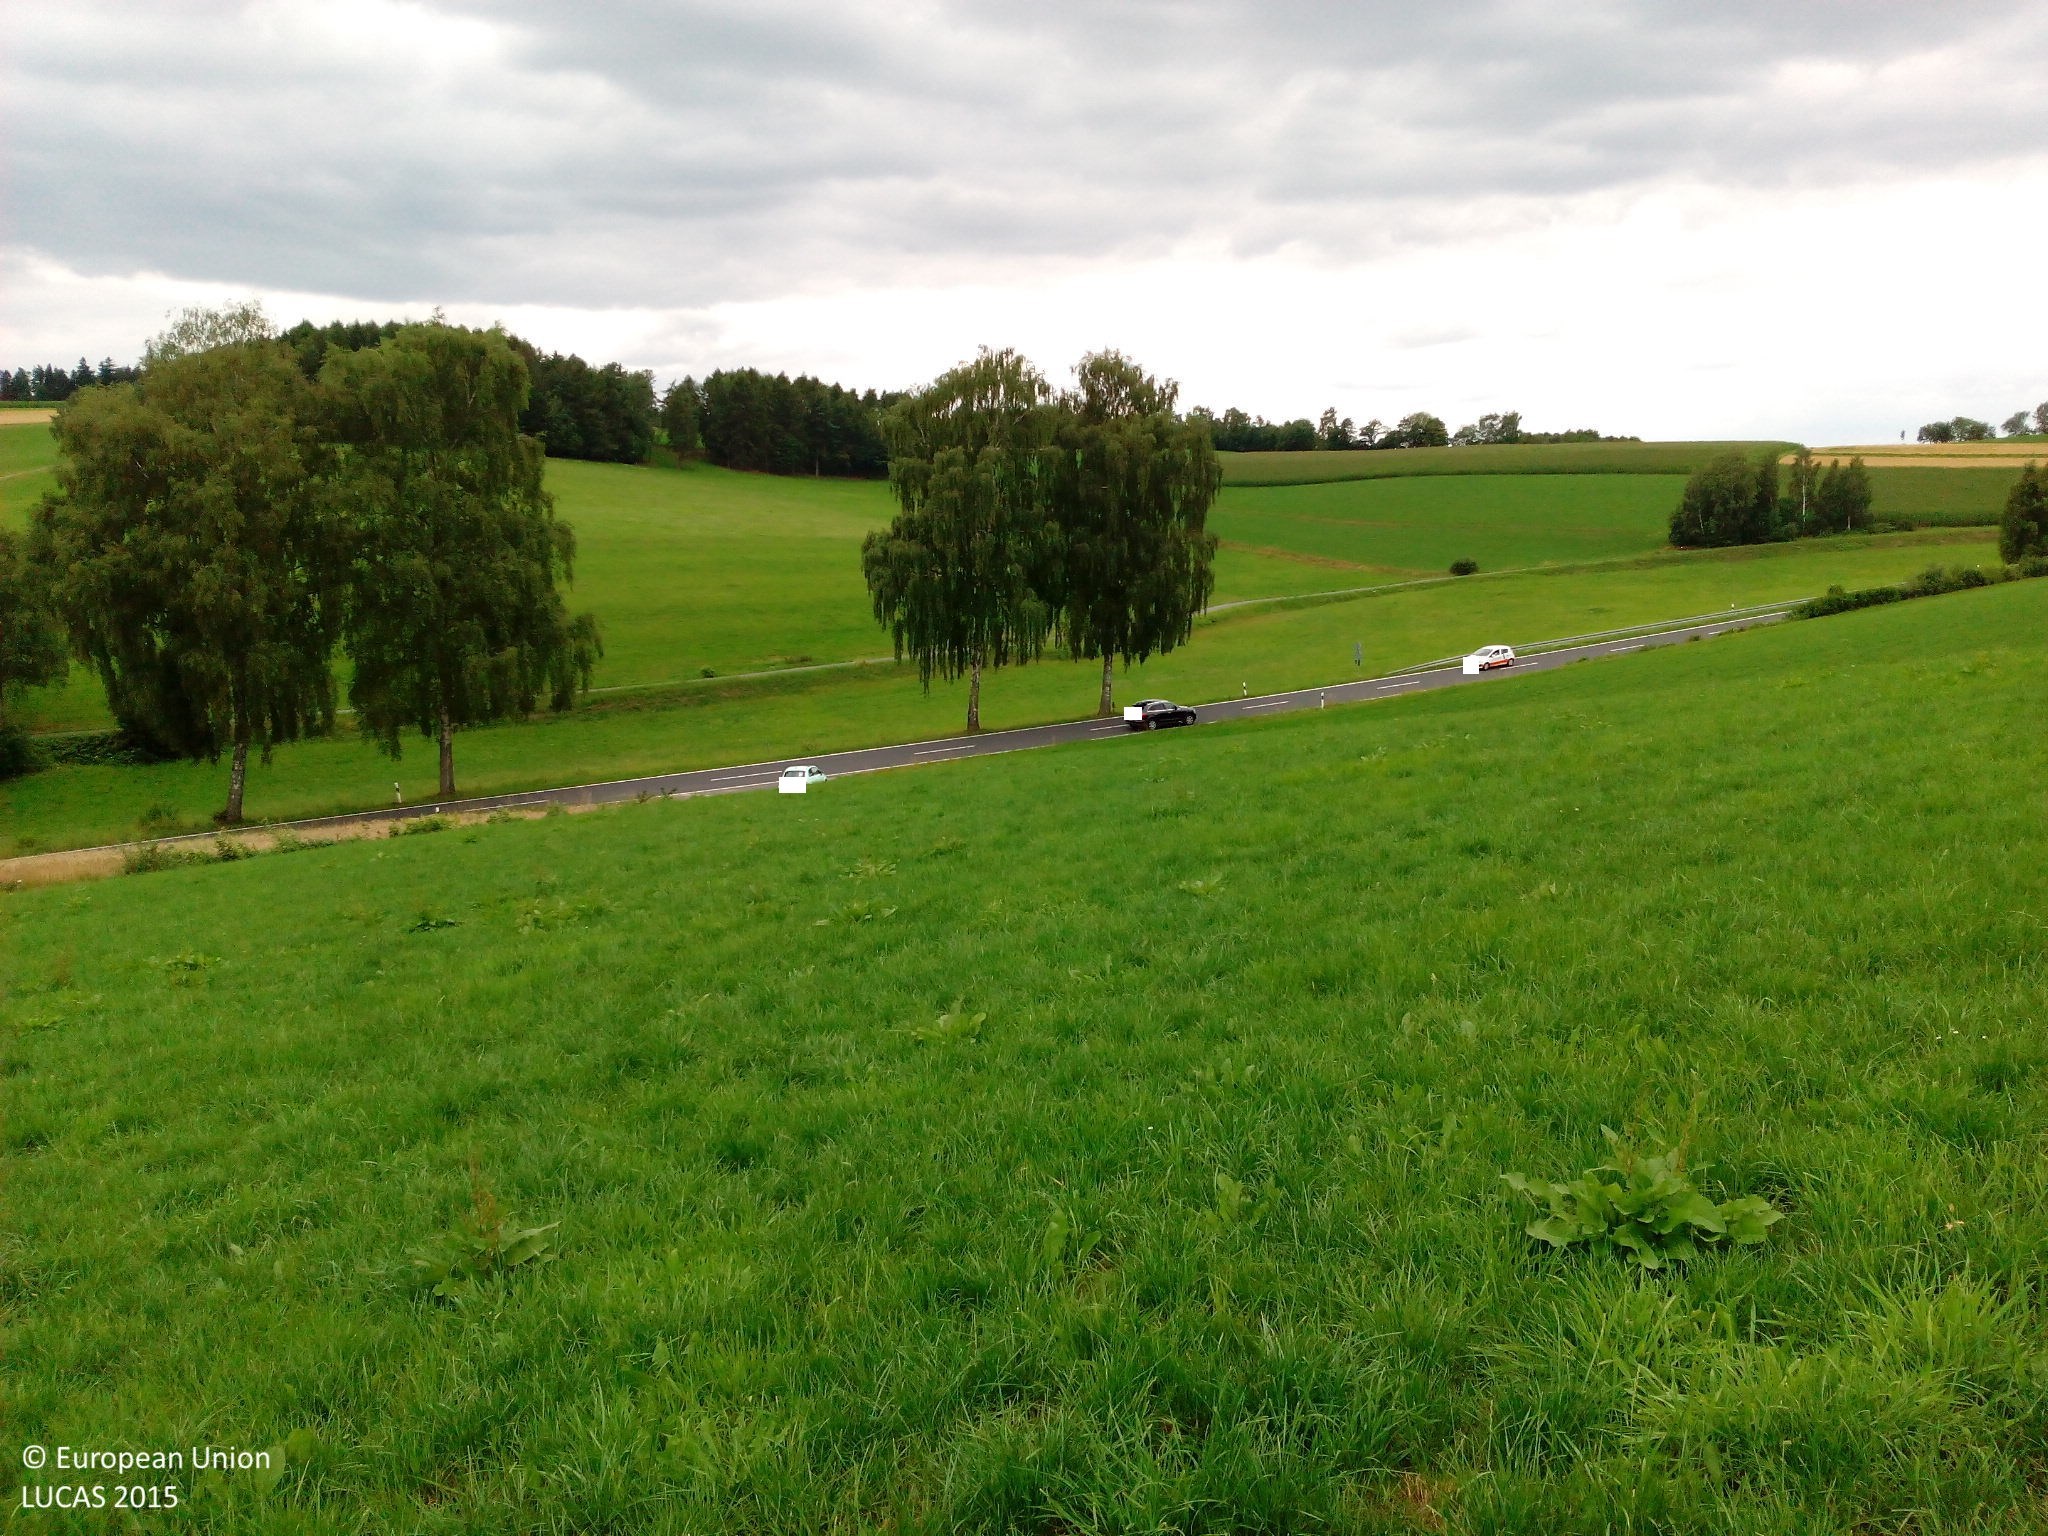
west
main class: Cropland
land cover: Barley
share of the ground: > 75 %
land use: Agriculture (excluding fallow land and kitchen gardens)
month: July
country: DE
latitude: 50.5078
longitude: 9.8731
